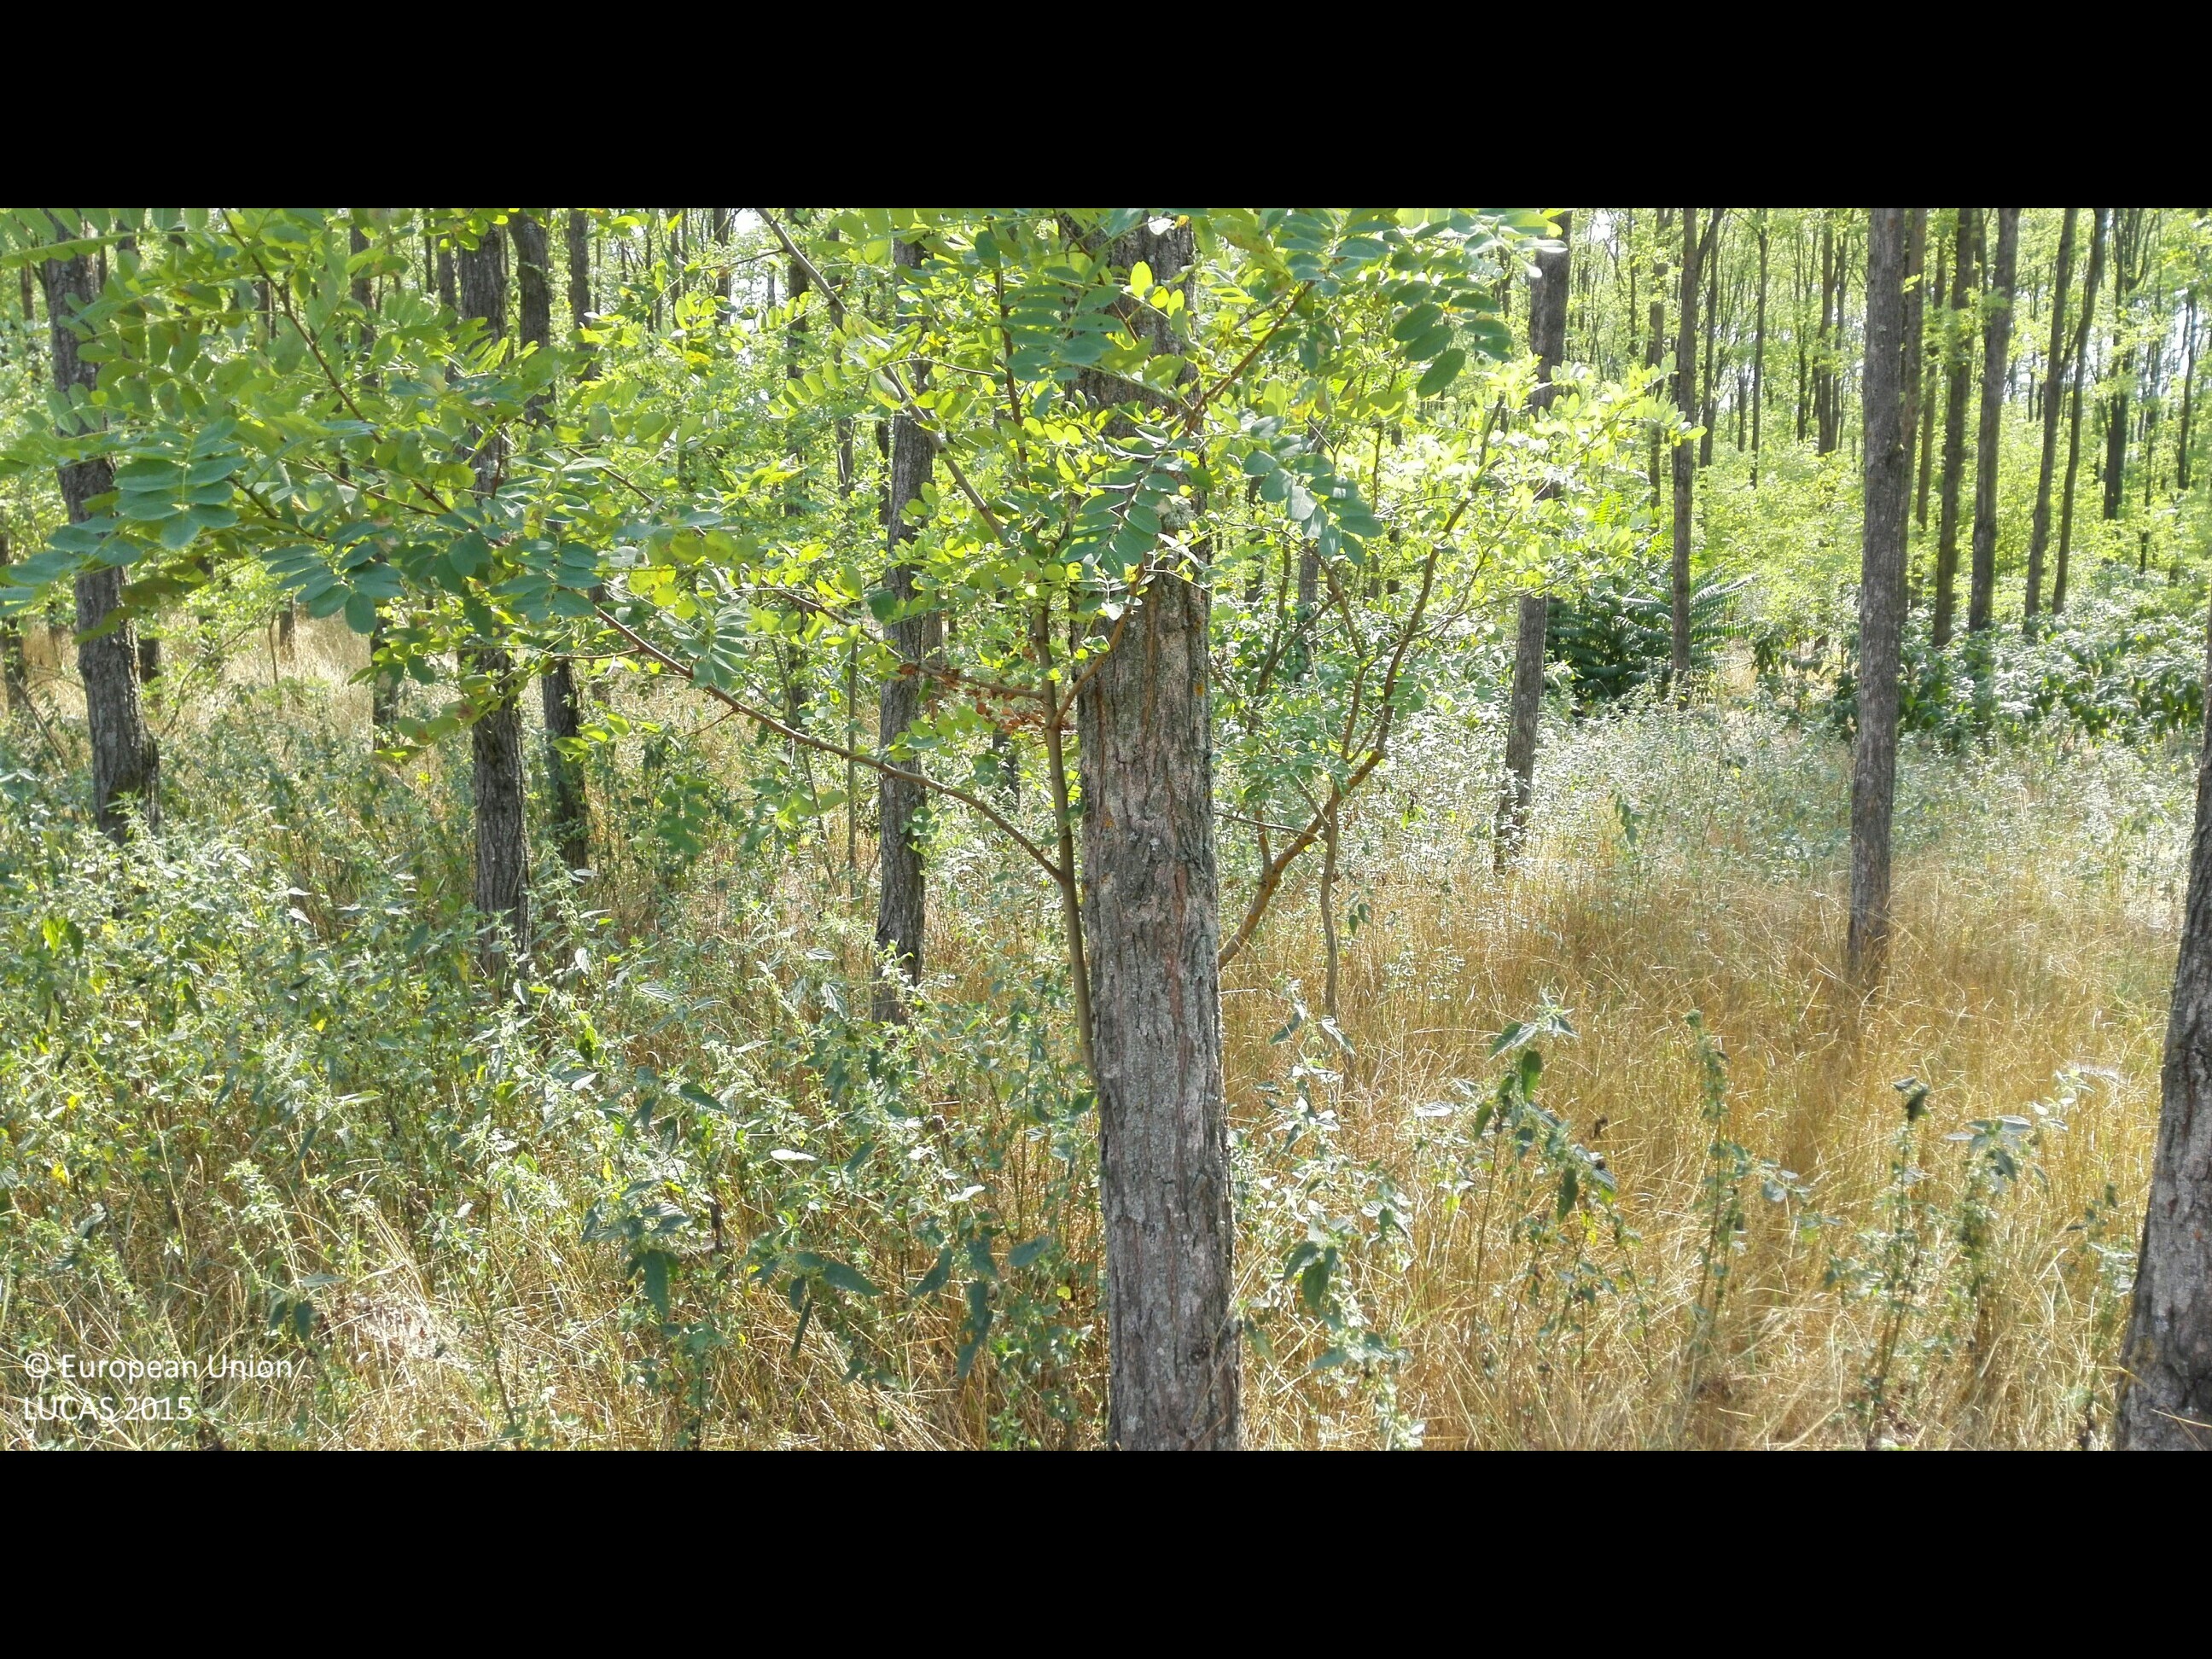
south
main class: Grassland
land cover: Grassland without tree/shrub cover
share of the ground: > 75 %
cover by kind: herbaceous plants 100 %
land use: Semi-natural and natural areas not in use
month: August
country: HU
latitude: 47.5151
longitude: 21.9604
